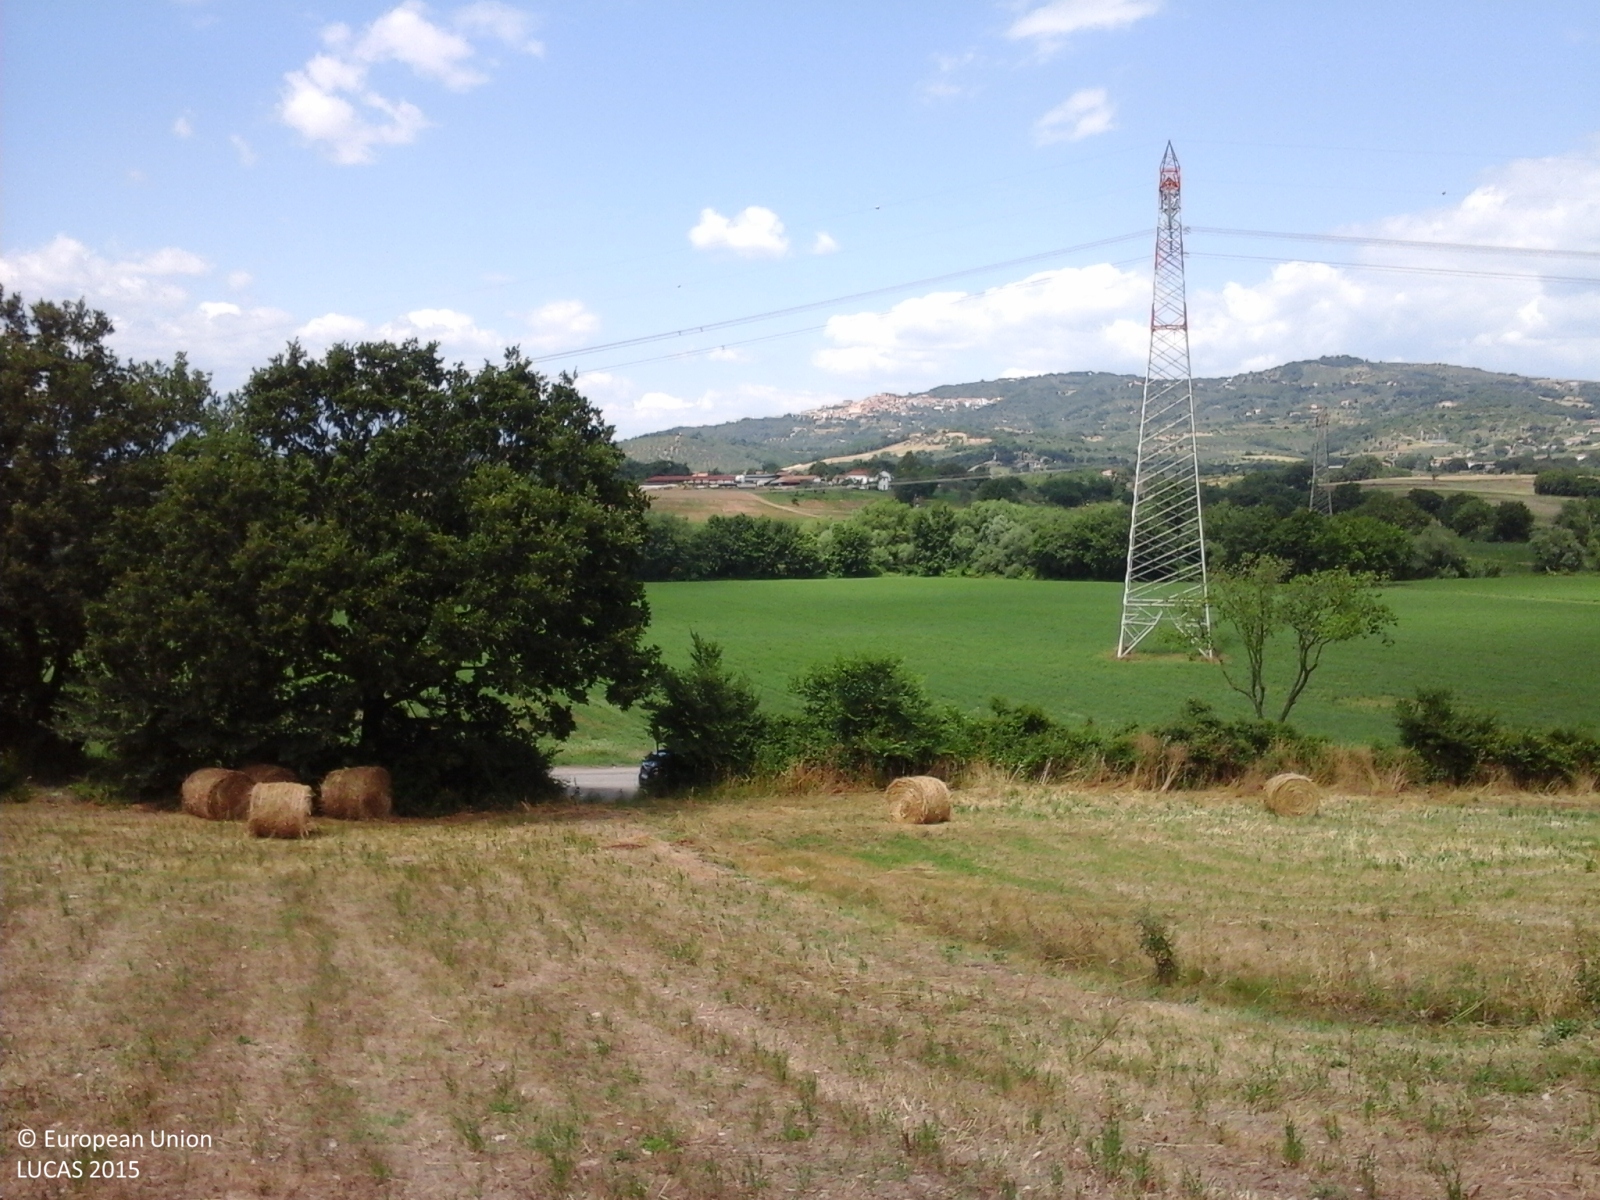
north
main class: Cropland
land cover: Temporary grasslands
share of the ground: > 75 %
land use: Agriculture (excluding fallow land and kitchen gardens)
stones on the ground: 10 - 25 %
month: June
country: IT
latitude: 40.4967
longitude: 15.1111
